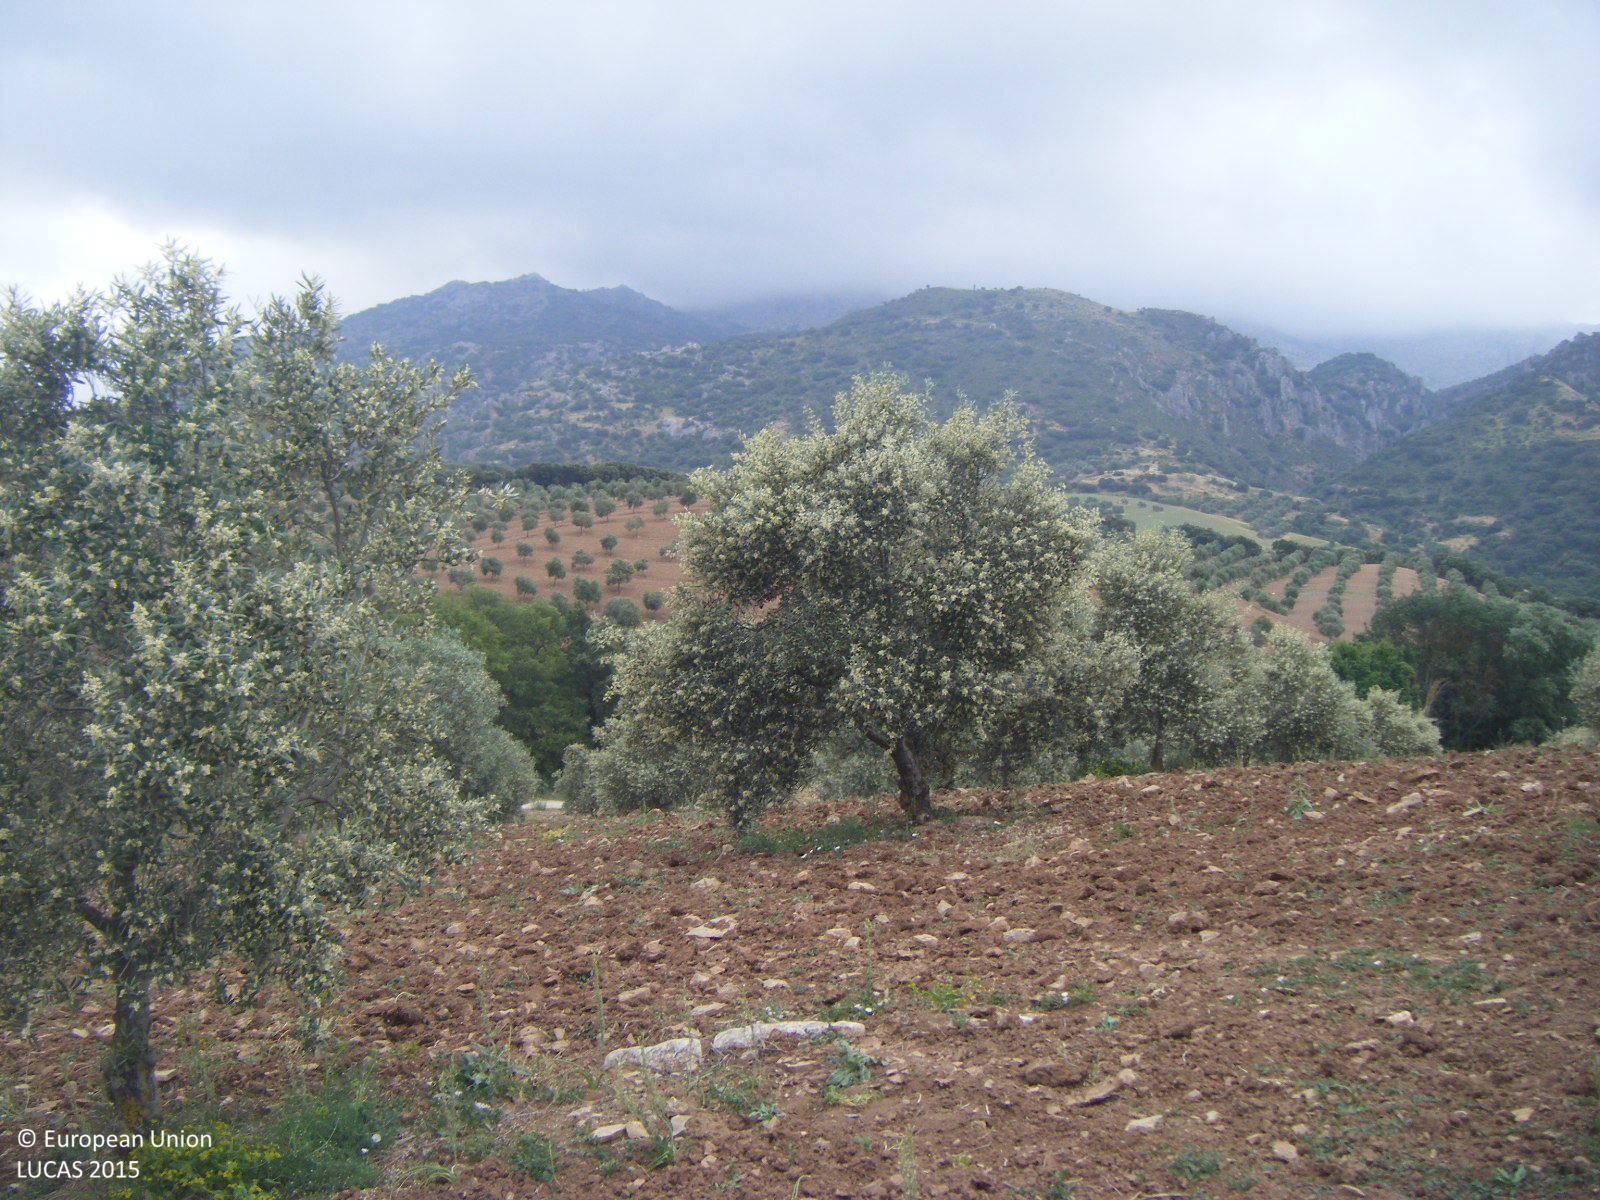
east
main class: Cropland
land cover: Olive groves
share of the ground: 10 - 25 %
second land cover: Other bare soil
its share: > 75 %
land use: Agriculture (excluding fallow land and kitchen gardens)
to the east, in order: Olive groves; Other bare soil; Ditches and canals; Tracks; Broadleaved woodland; Rivers and streams; Broadleaved woodland; Olive groves
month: May
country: ES
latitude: 36.9753
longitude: -4.4066
